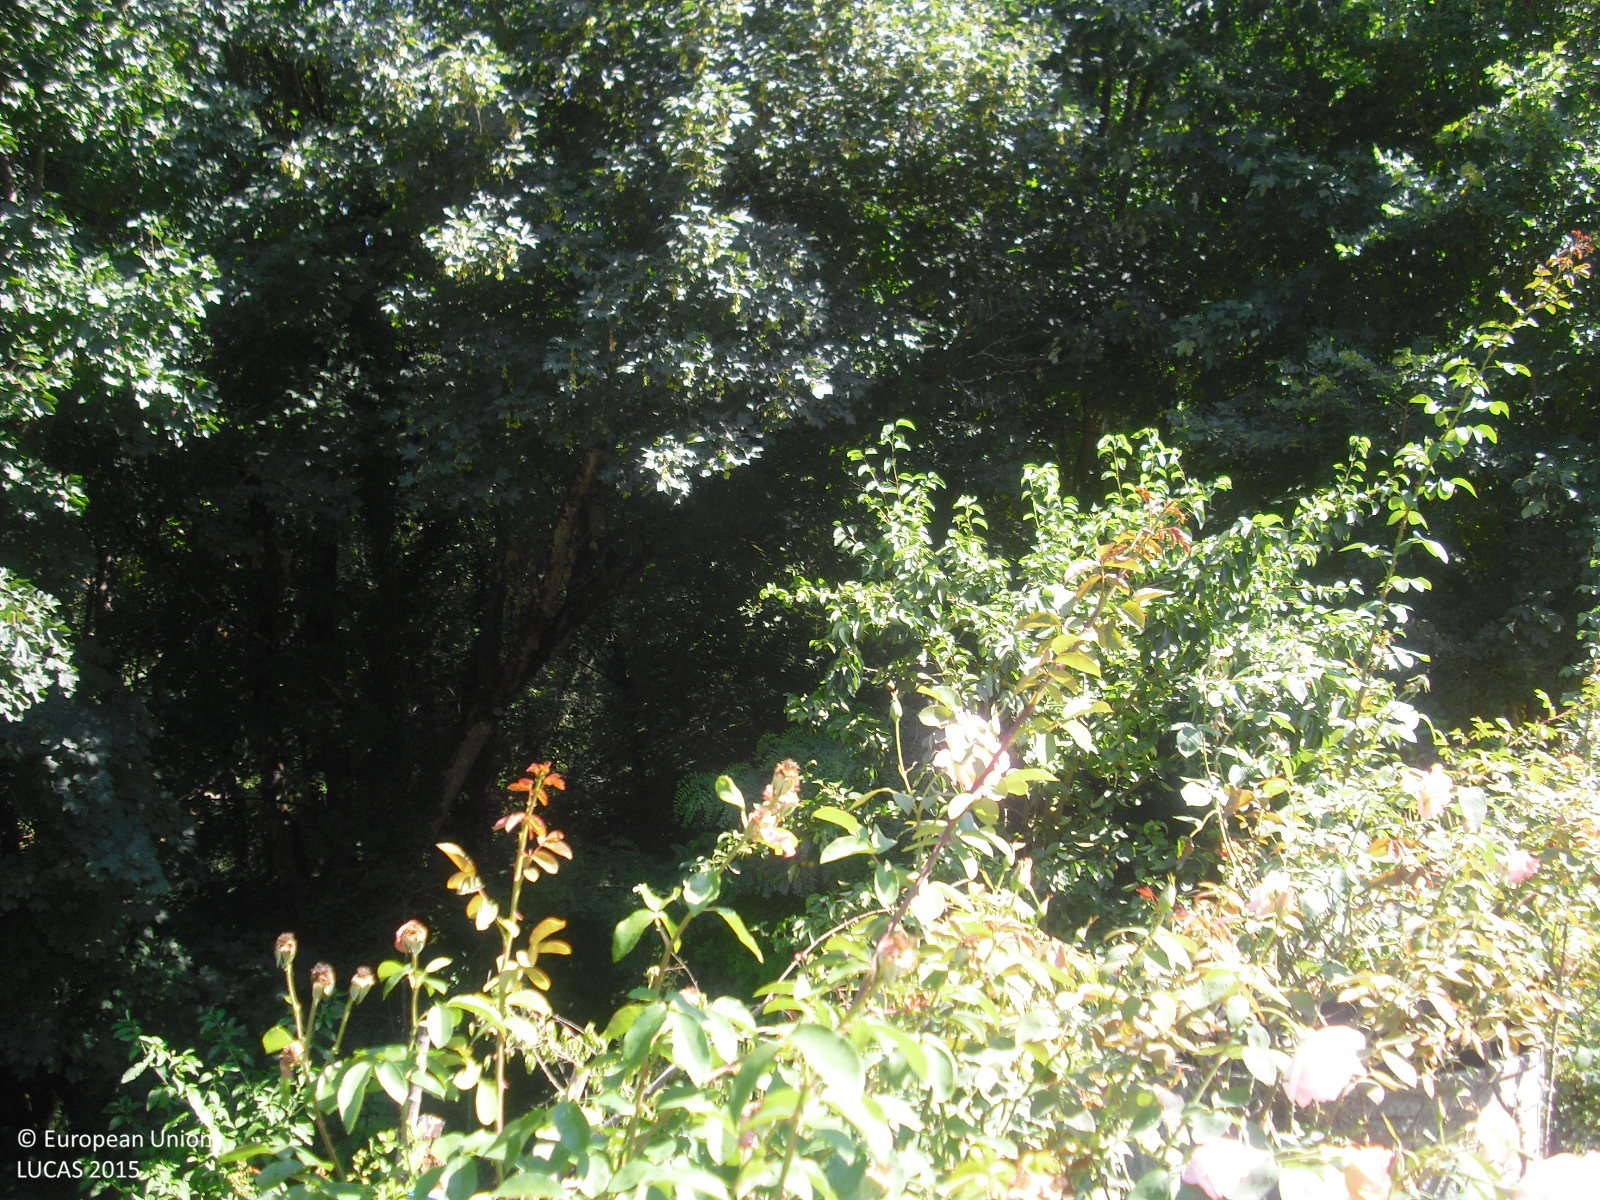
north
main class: Cropland
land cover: Other fruit trees and berries
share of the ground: 50 - 75 %
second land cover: Spontaneously vegetated surfaces
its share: 50 - 75 %
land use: Agriculture (excluding fallow land and kitchen gardens)
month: July
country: ES
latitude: 42.4909
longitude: -7.2291
